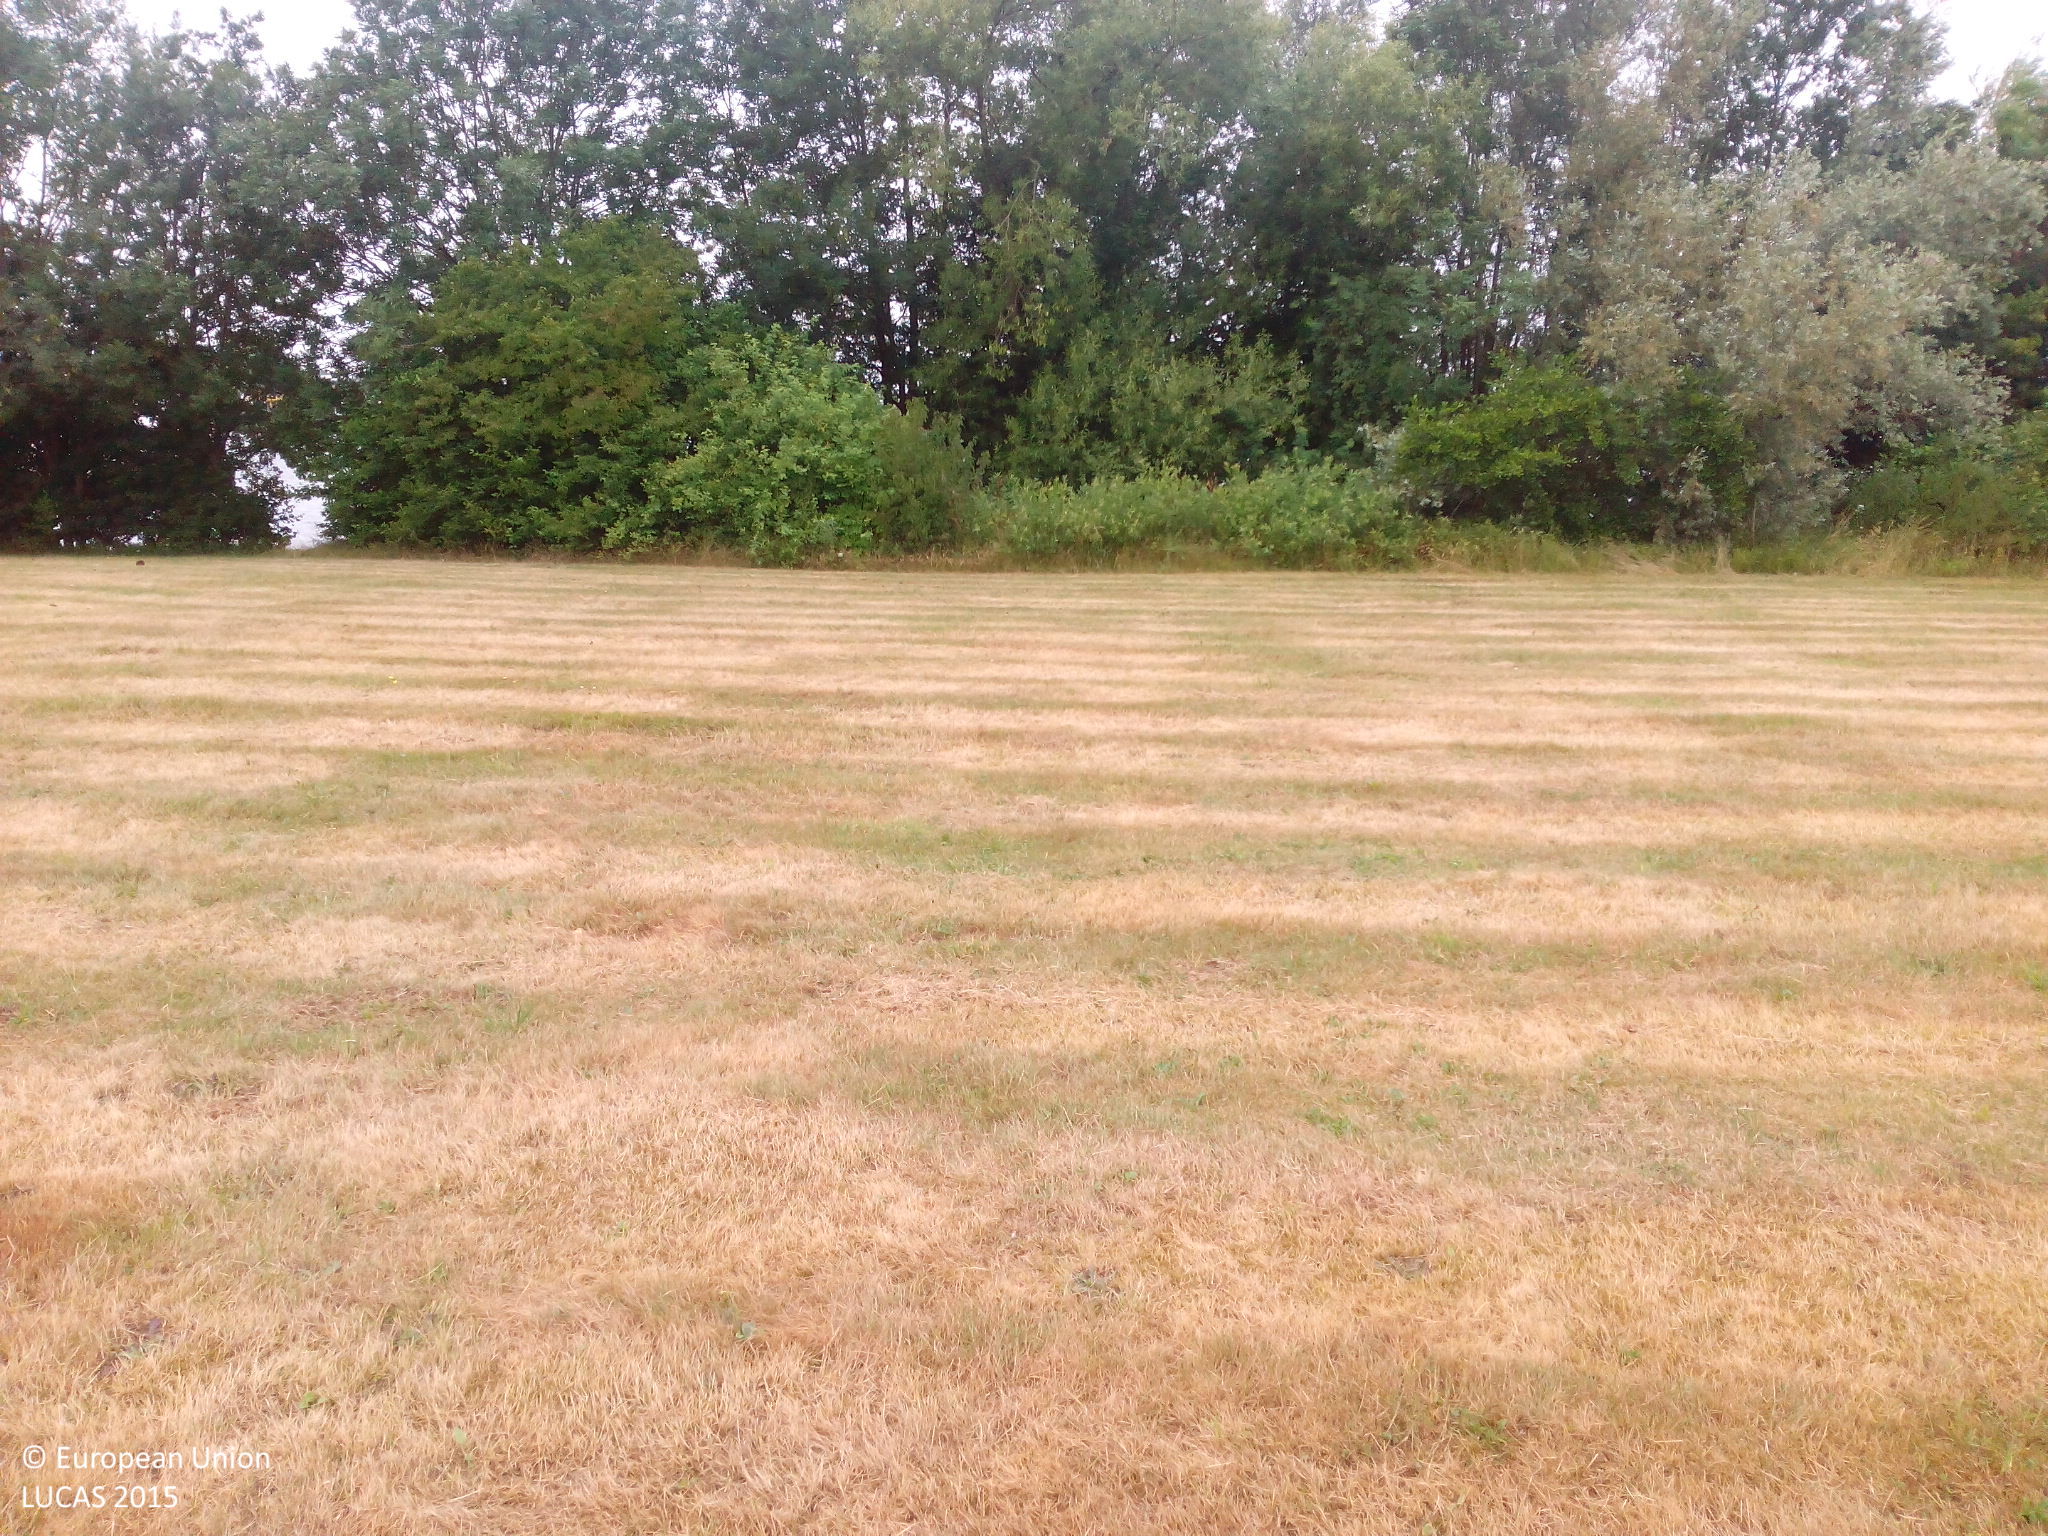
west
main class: Grassland
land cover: Grassland without tree/shrub cover
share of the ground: > 75 %
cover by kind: herbaceous plants 100 %
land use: Amenities, museums, leisure
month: July
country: NL
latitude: 51.8258
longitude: 5.5439
